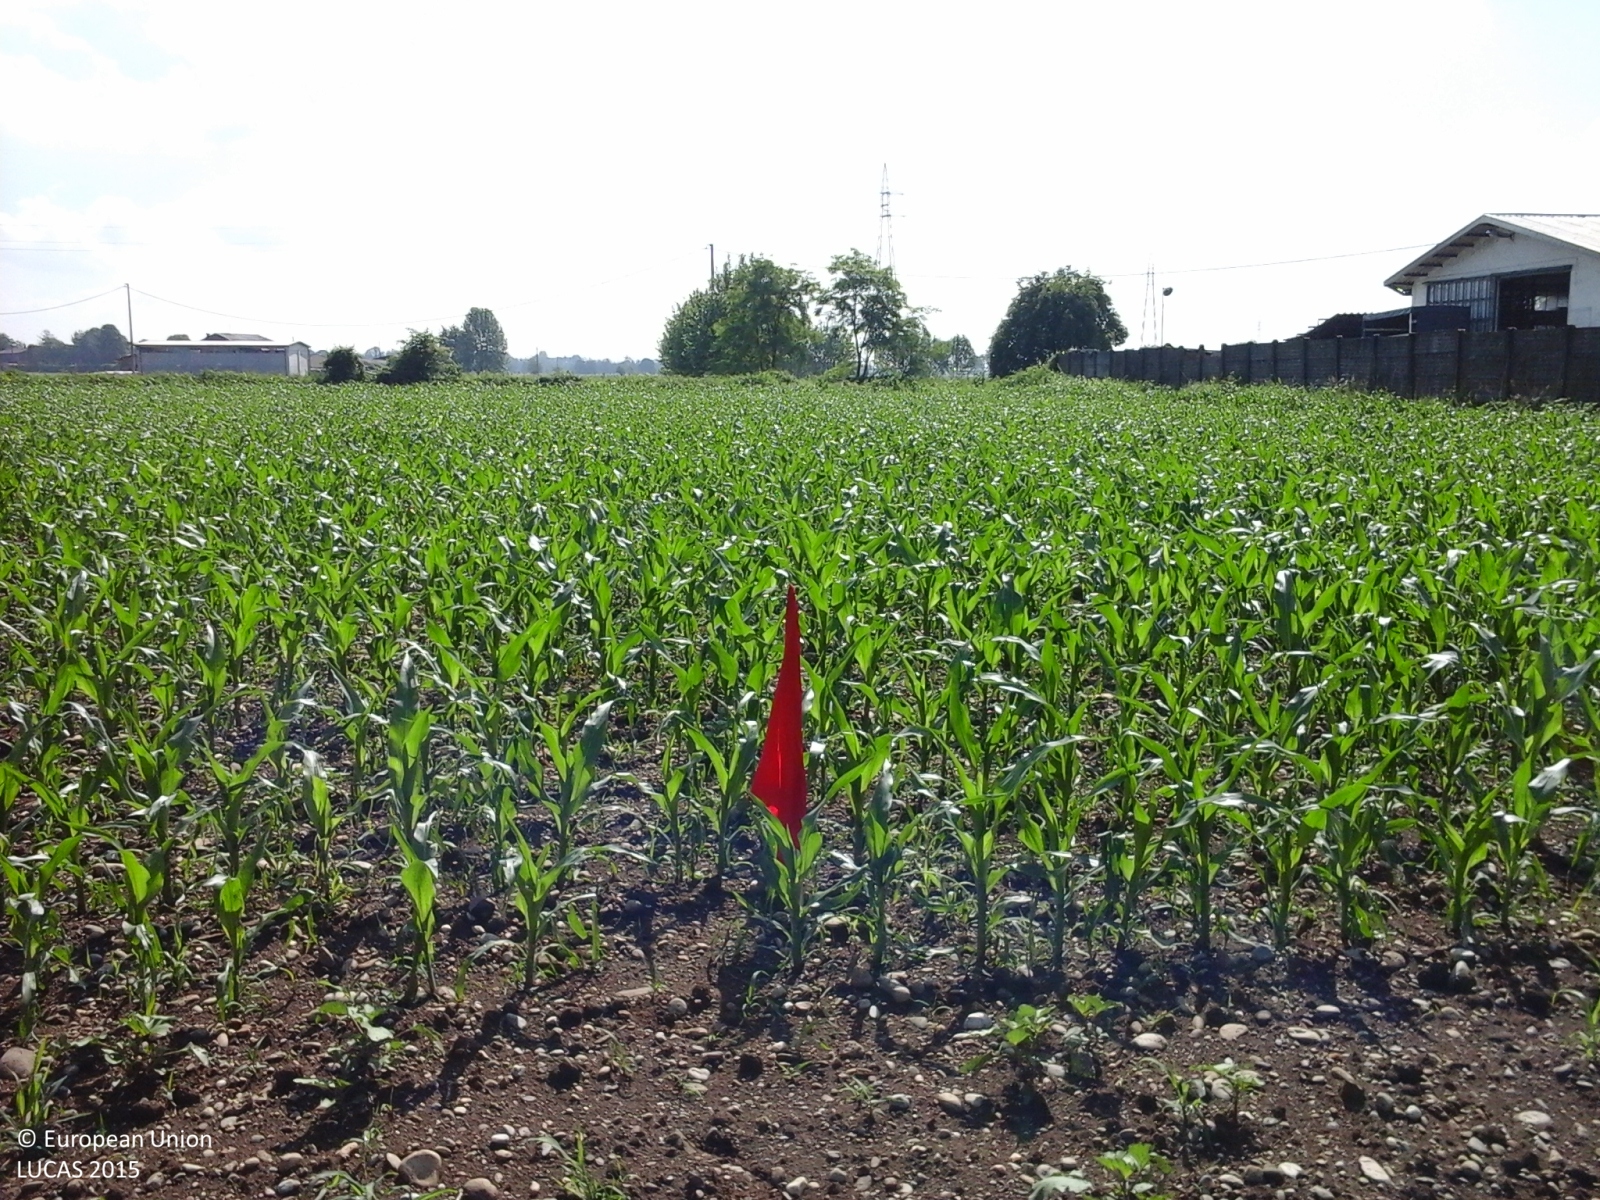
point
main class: Cropland
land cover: Maize
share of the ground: 50 - 75 %
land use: Agriculture (excluding fallow land and kitchen gardens)
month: May
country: IT
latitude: 45.4133
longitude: 9.5536
